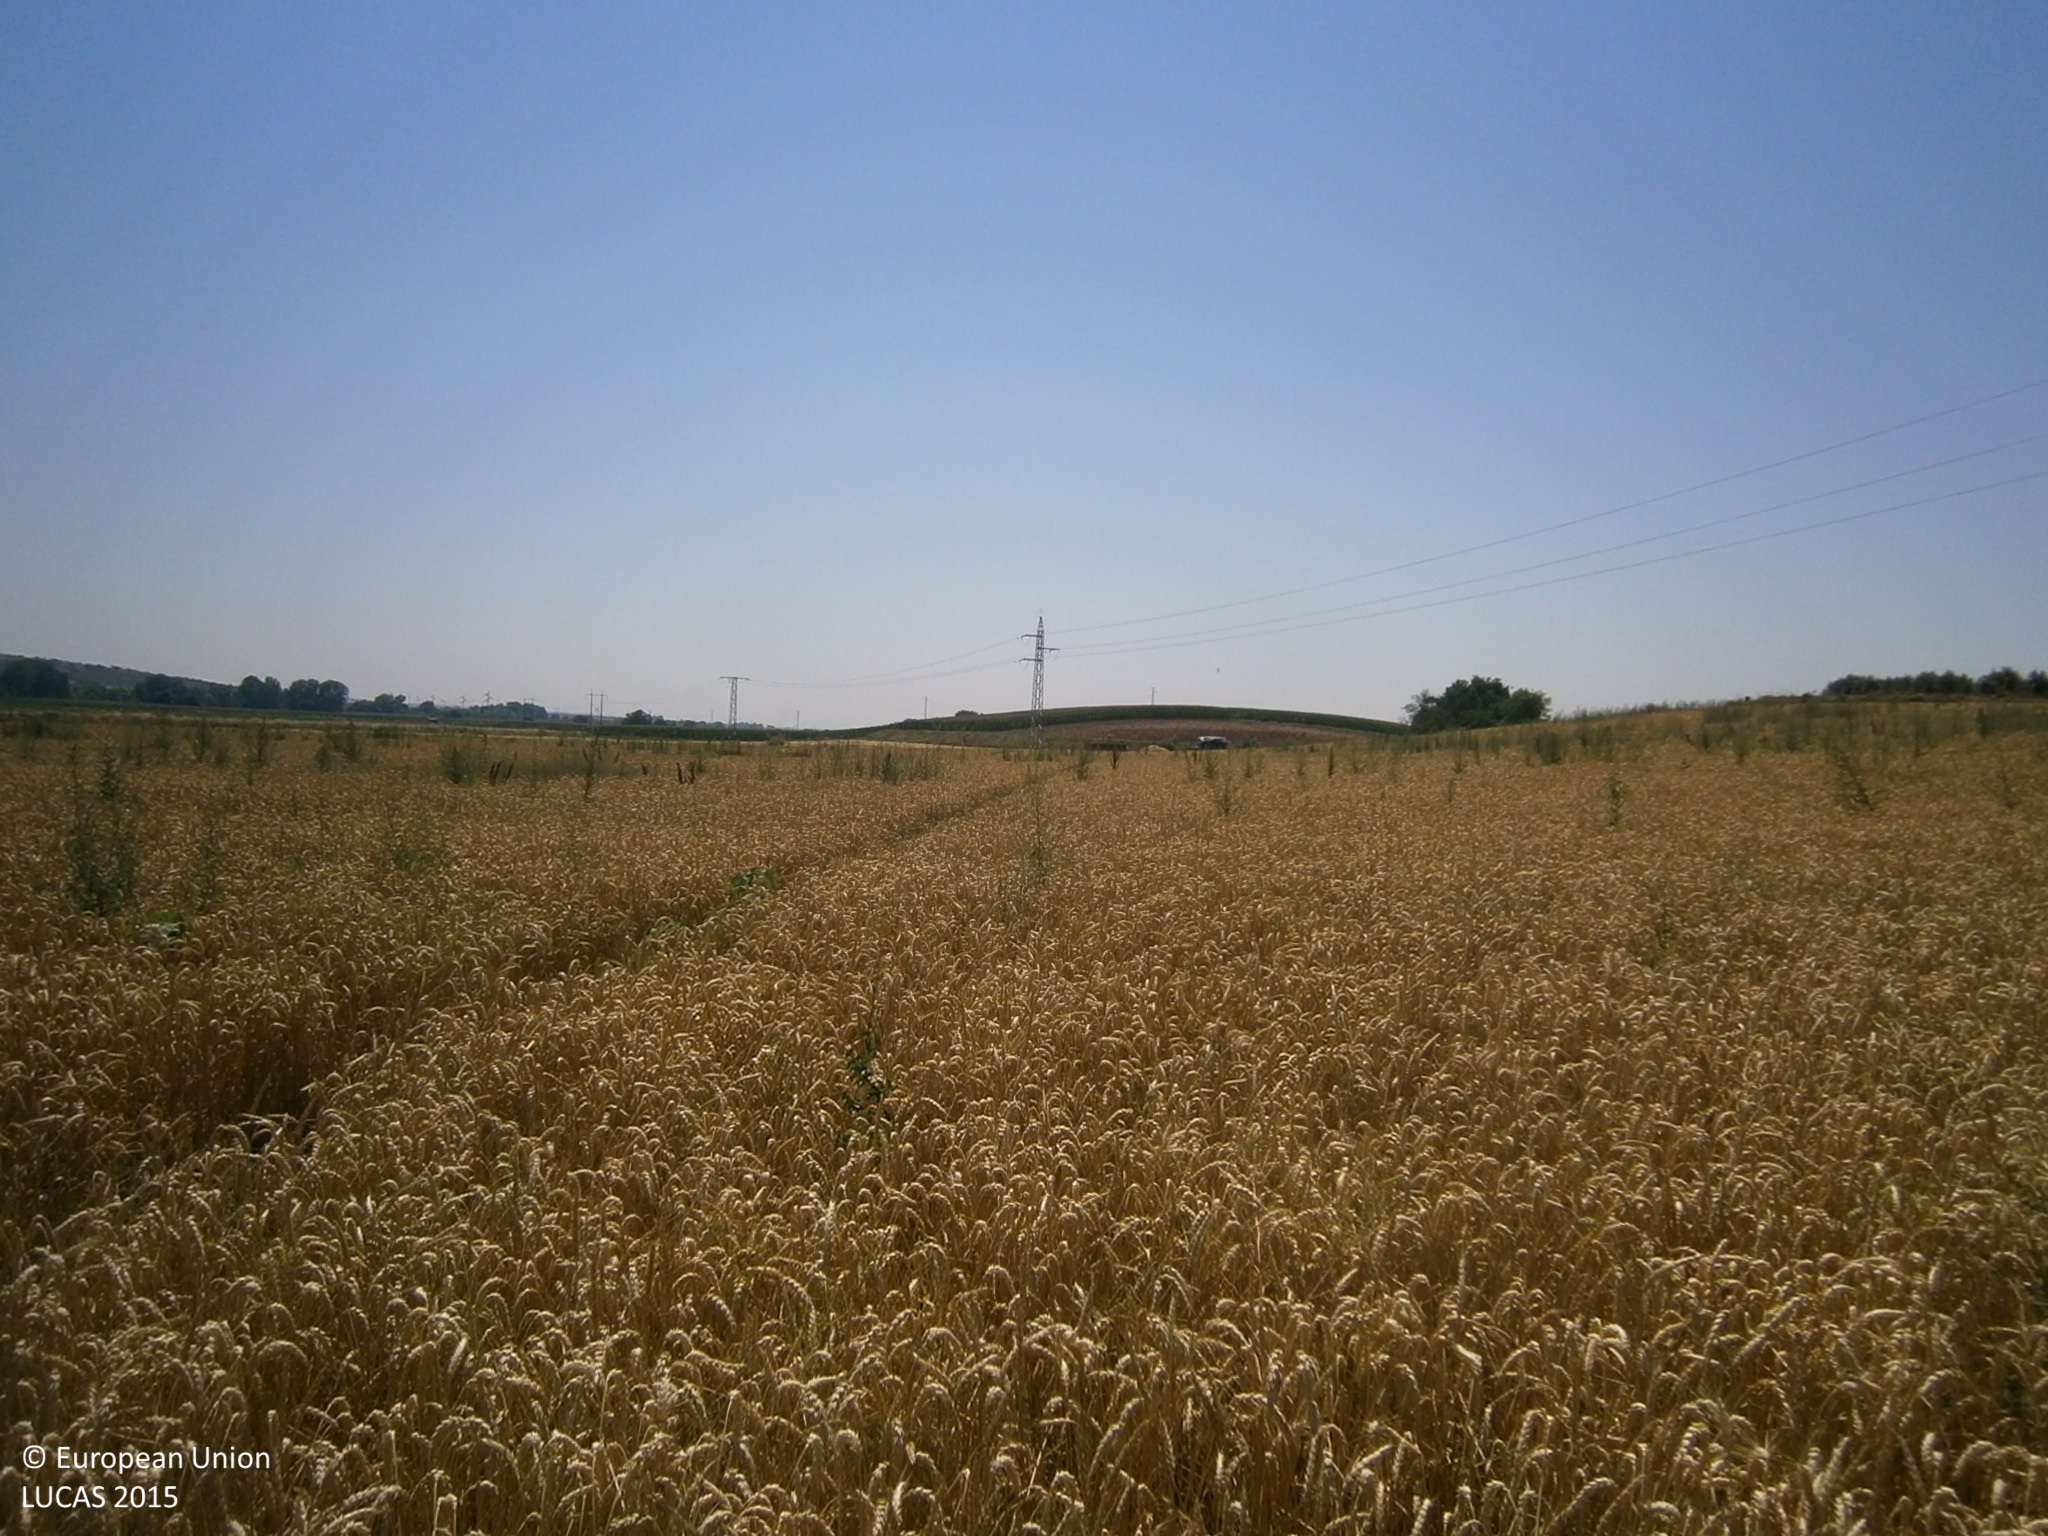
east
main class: Cropland
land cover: Barley
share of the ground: > 75 %
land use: Agriculture (excluding fallow land and kitchen gardens)
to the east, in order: Barley; Common wheat; Tracks; Rivers and streams; Tracks
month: June
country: ES
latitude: 38.8449
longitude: -6.6889
